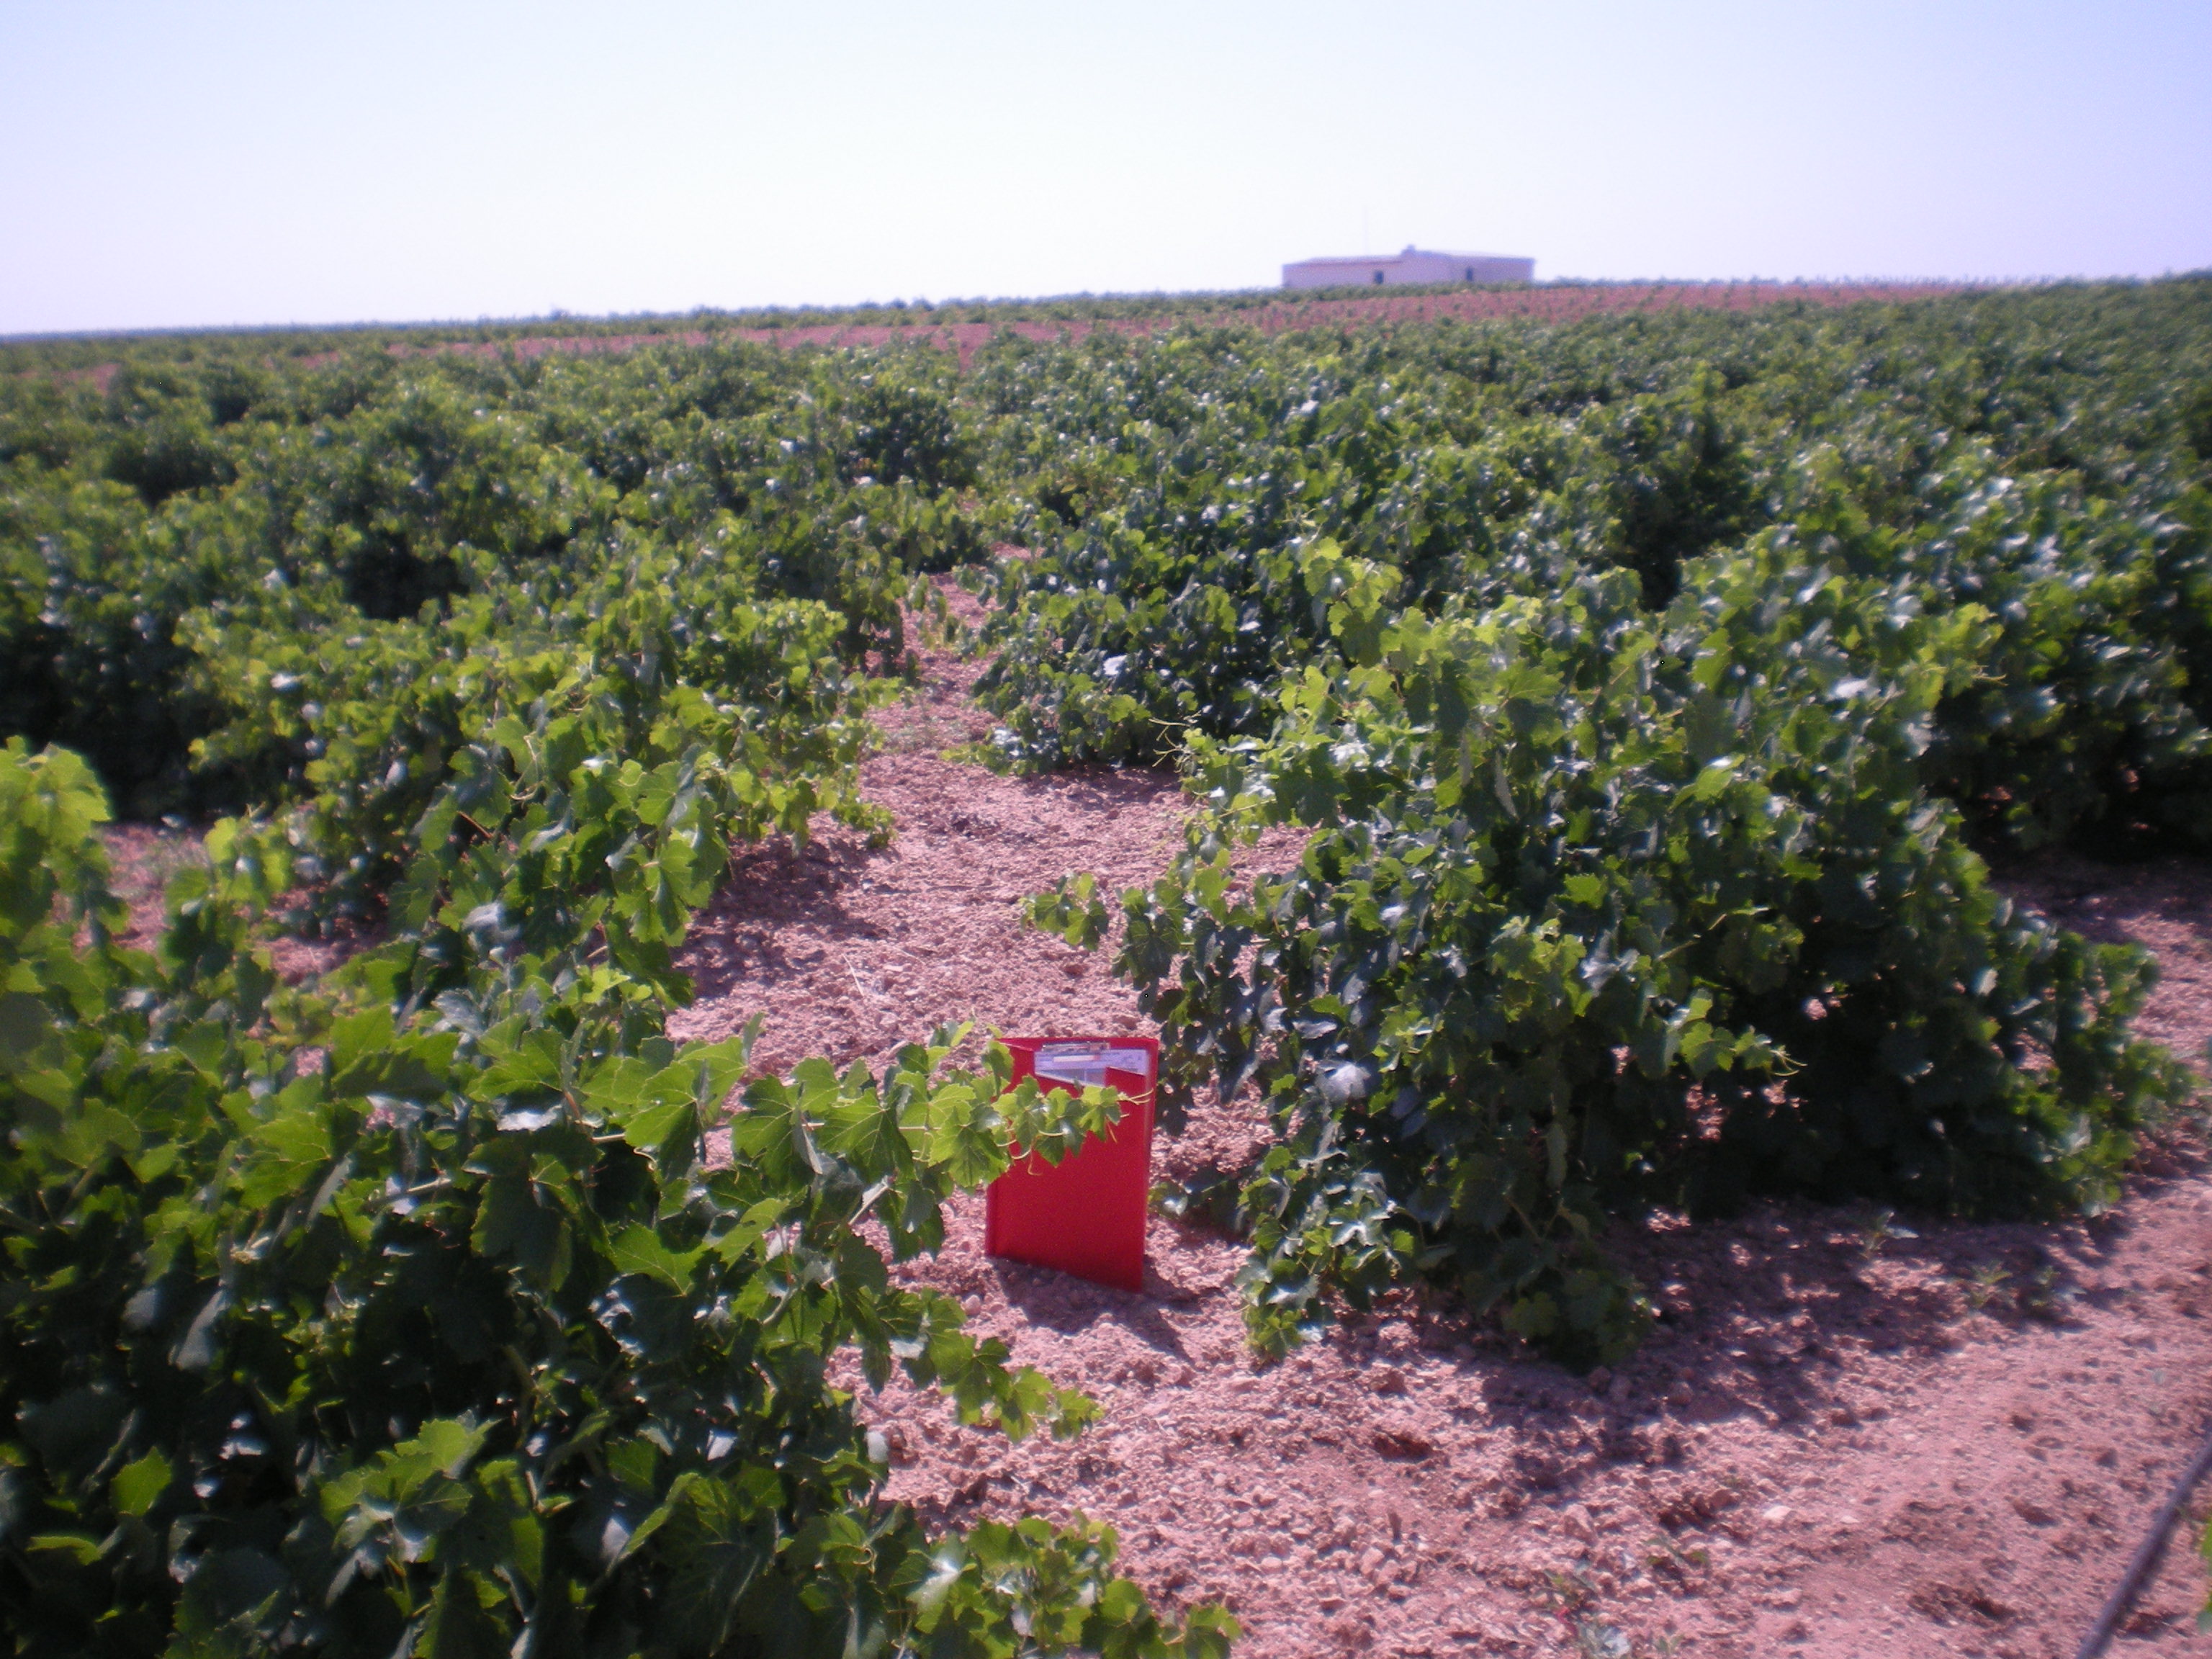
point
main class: Cropland
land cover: Vineyards
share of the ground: 25 - 50 %
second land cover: Other bare soil
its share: > 75 %
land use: Agriculture (excluding fallow land and kitchen gardens)
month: July
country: ES
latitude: 39.2692
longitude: -3.0073
